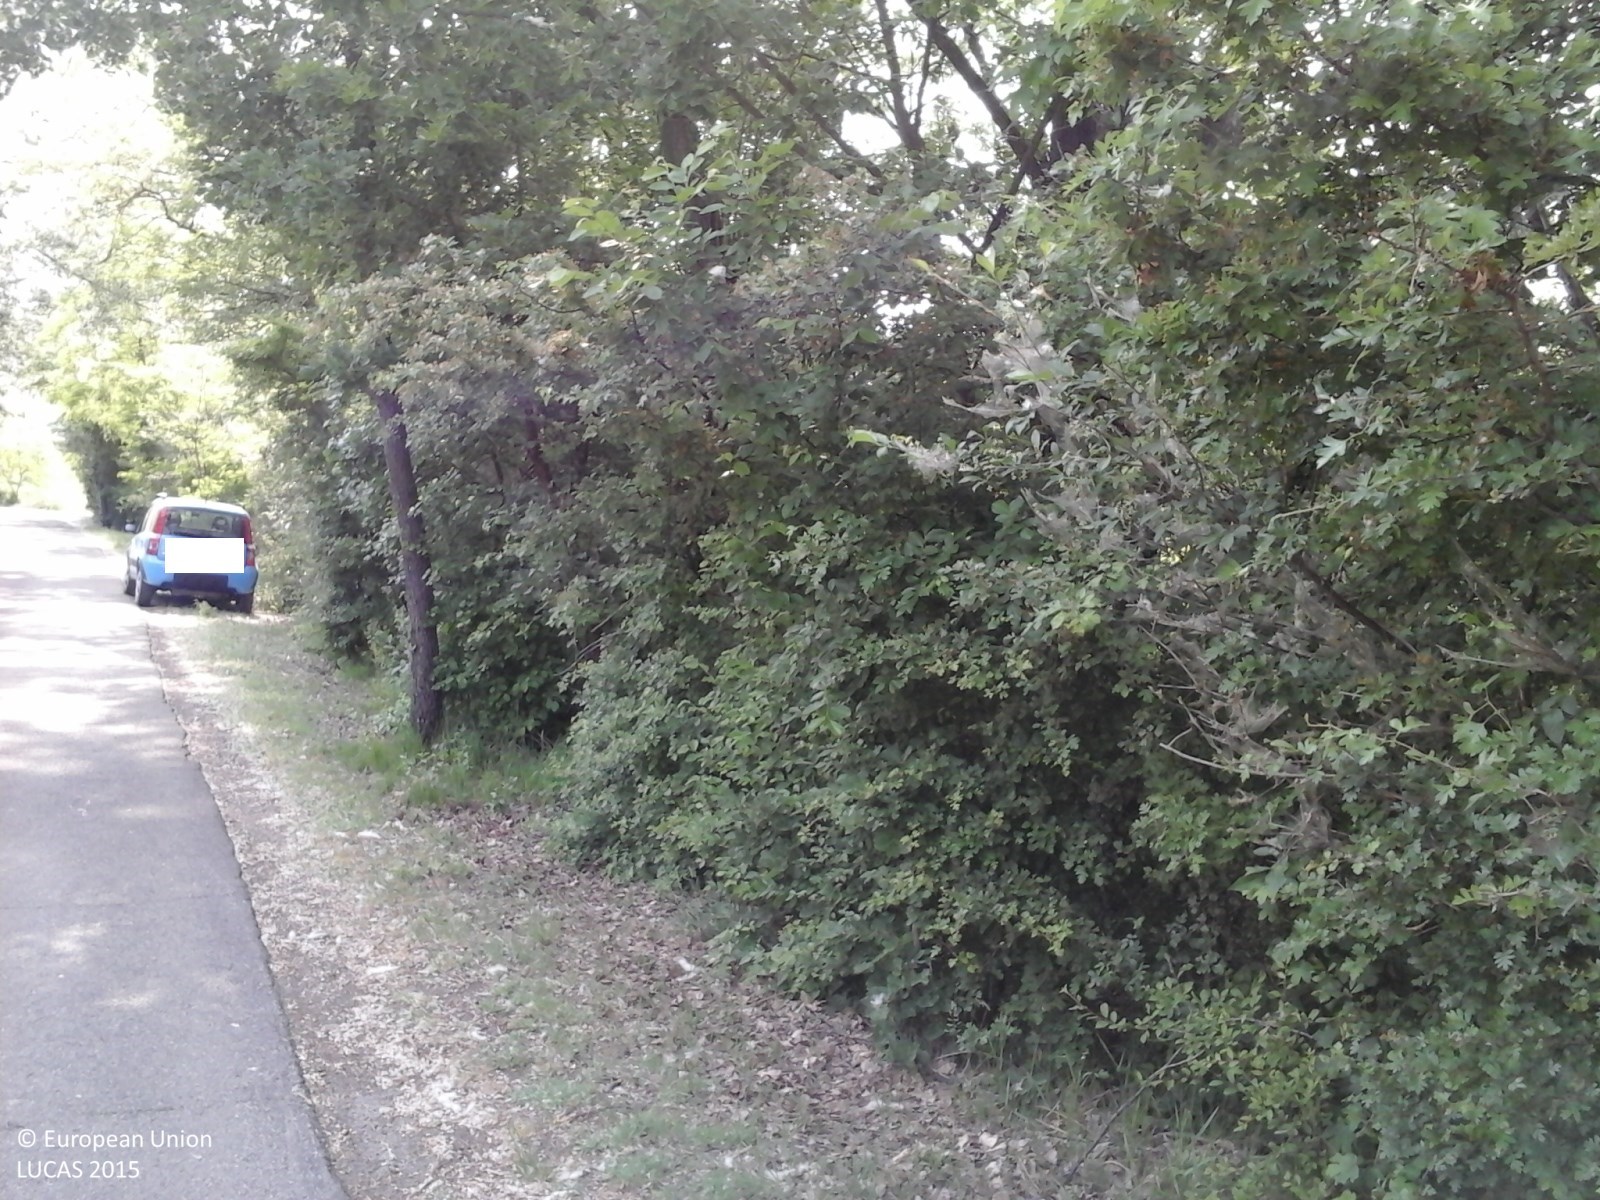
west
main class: Woodland
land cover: Broadleaved woodland
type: thermophilous deciduous forest
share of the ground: > 75 %
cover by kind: broadleaved forest trees 100 %
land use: Semi-natural and natural areas not in use
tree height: > 5 m
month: May
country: IT
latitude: 44.5829
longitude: 10.6661
